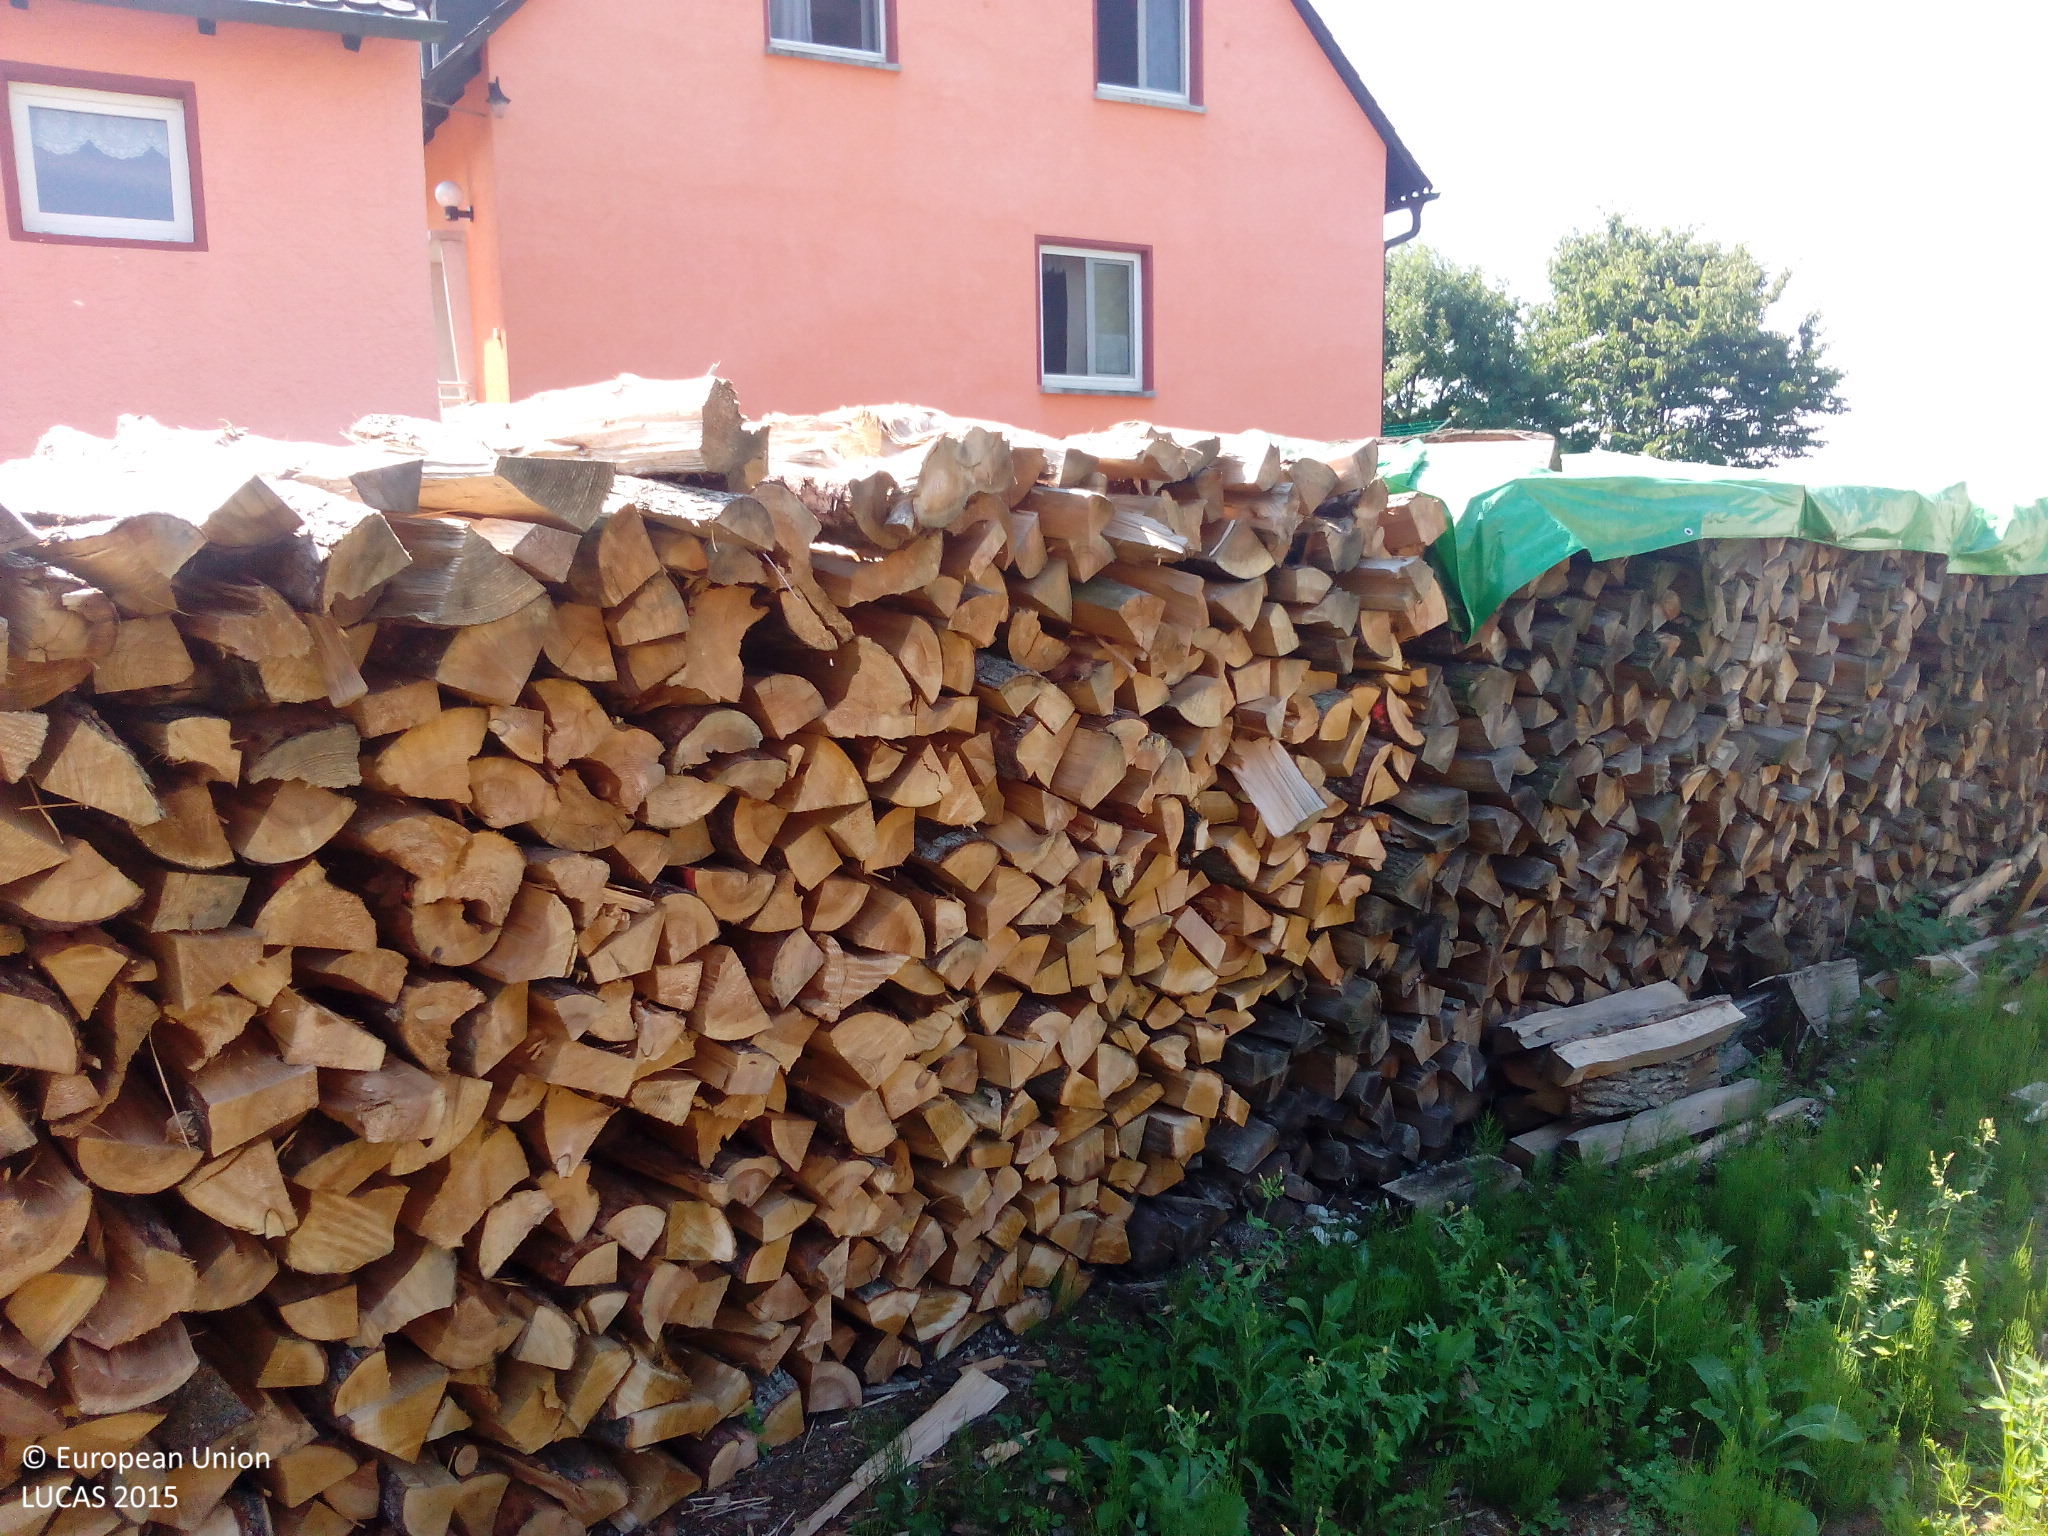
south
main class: Grassland
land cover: Spontaneously vegetated surfaces
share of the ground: > 75 %
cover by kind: herbaceous plants 55 %, unconsolidated bare surface 45 %
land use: Logistics and storage
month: July
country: DE
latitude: 49.7836
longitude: 11.0691
